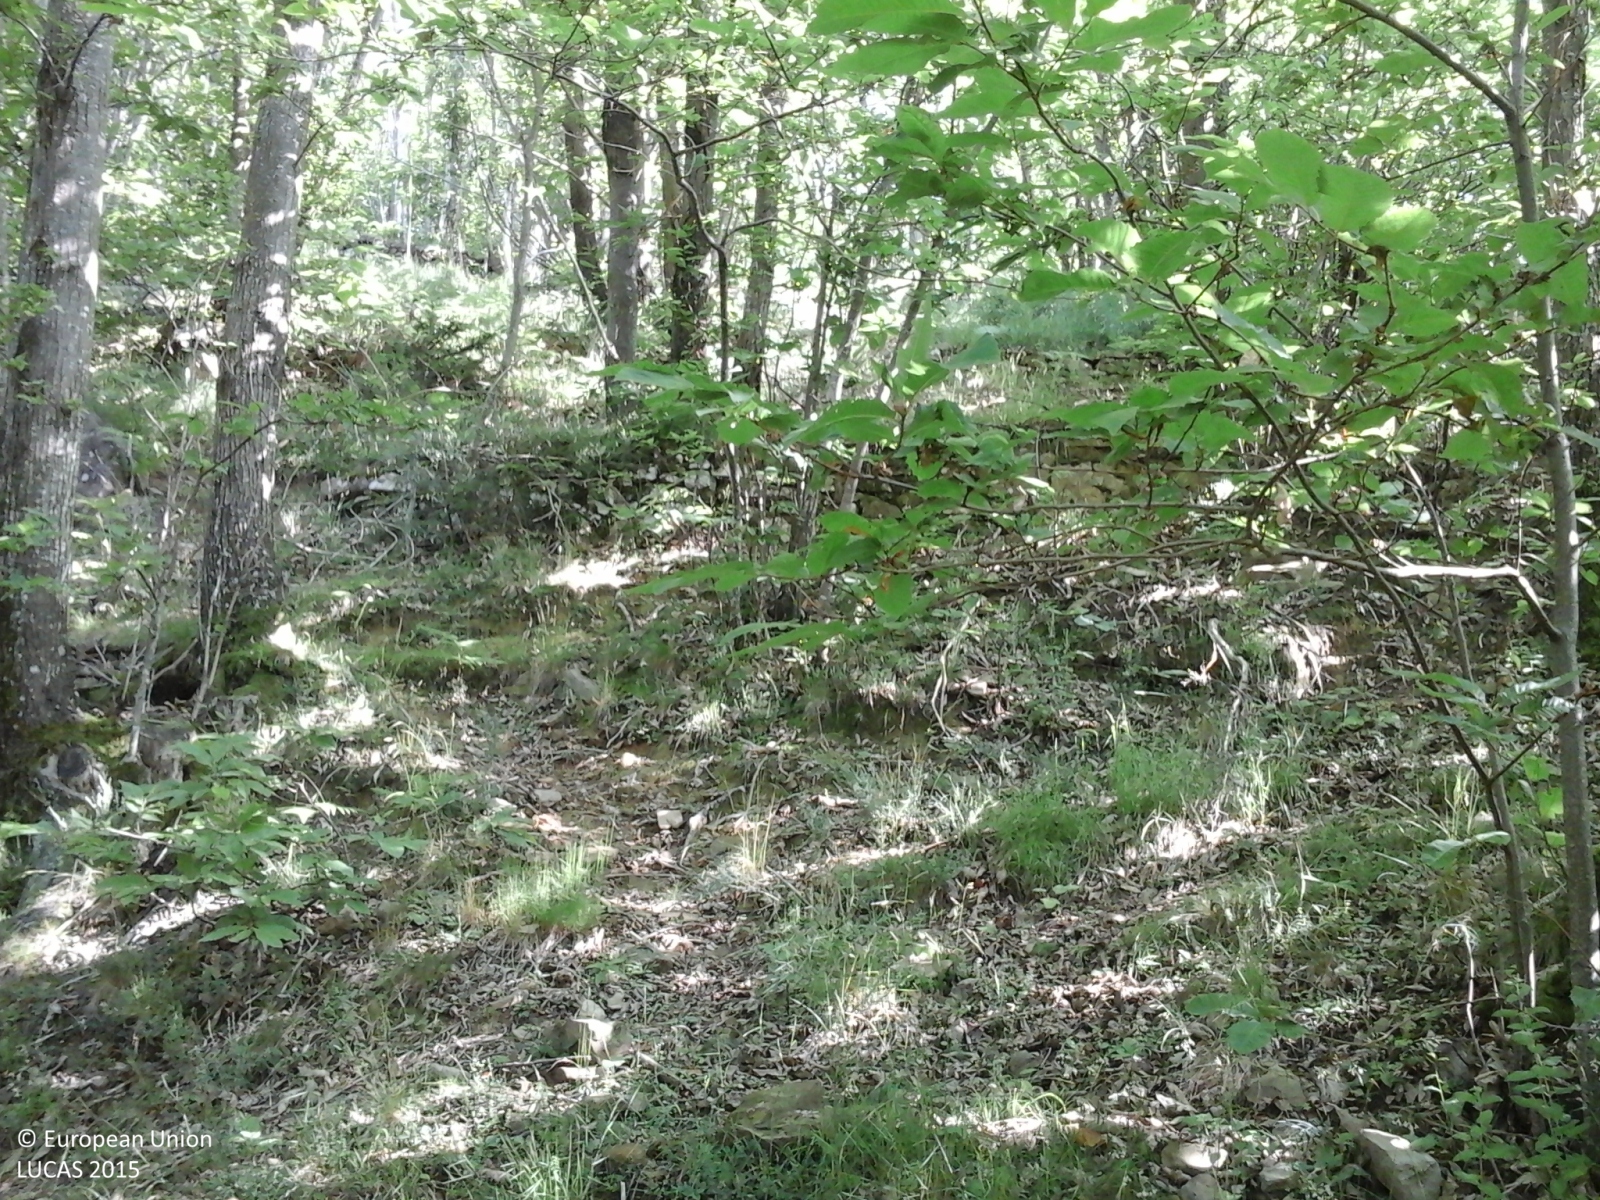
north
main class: Woodland
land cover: Broadleaved woodland
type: thermophilous deciduous forest
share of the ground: > 75 %
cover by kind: broadleaved forest trees 100 %
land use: Forestry
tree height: > 5 m
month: June
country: IT
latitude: 44.0933
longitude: 10.9843
